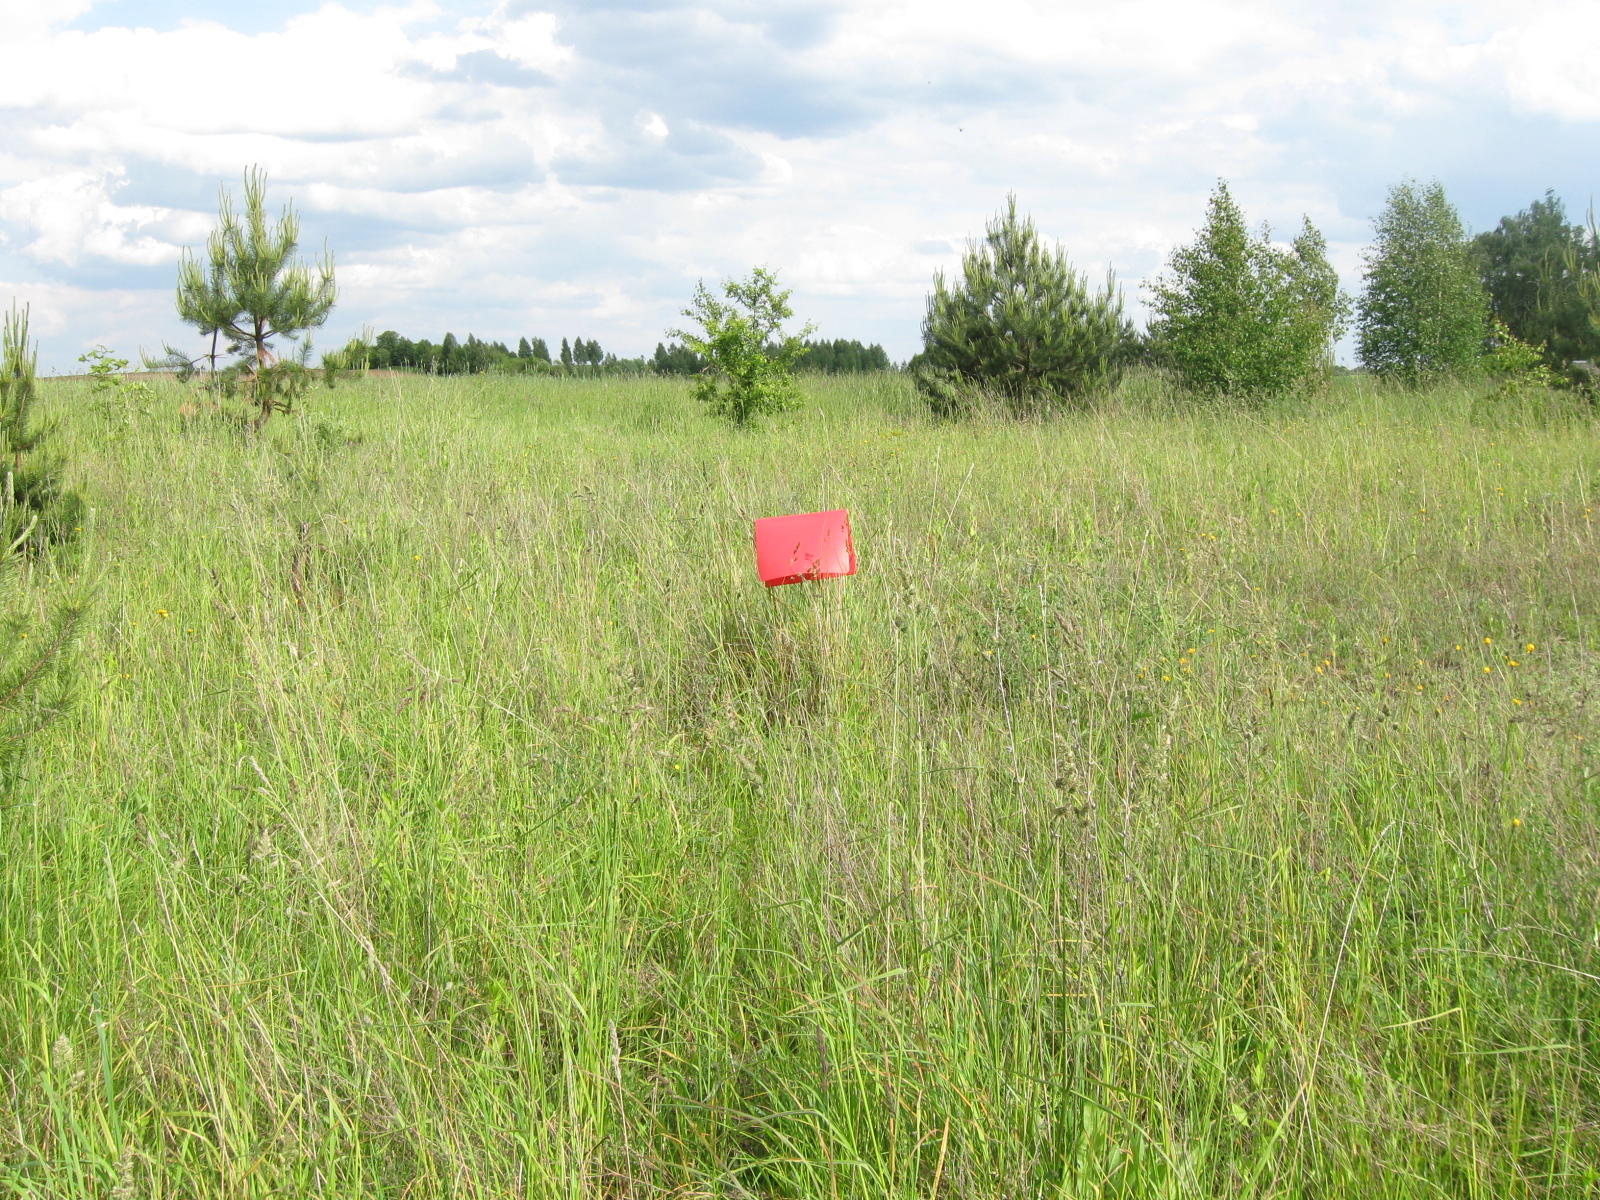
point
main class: Grassland
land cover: Grassland with sparse tree/shrub cover
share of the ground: > 75 %
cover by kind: herbaceous plants 90 %, coniferous forest trees 5 %, unconsolidated bare surface 5 %
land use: Agriculture (excluding fallow land and kitchen gardens)
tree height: < 5 m
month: June
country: LT
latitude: 54.2965
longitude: 23.8723
